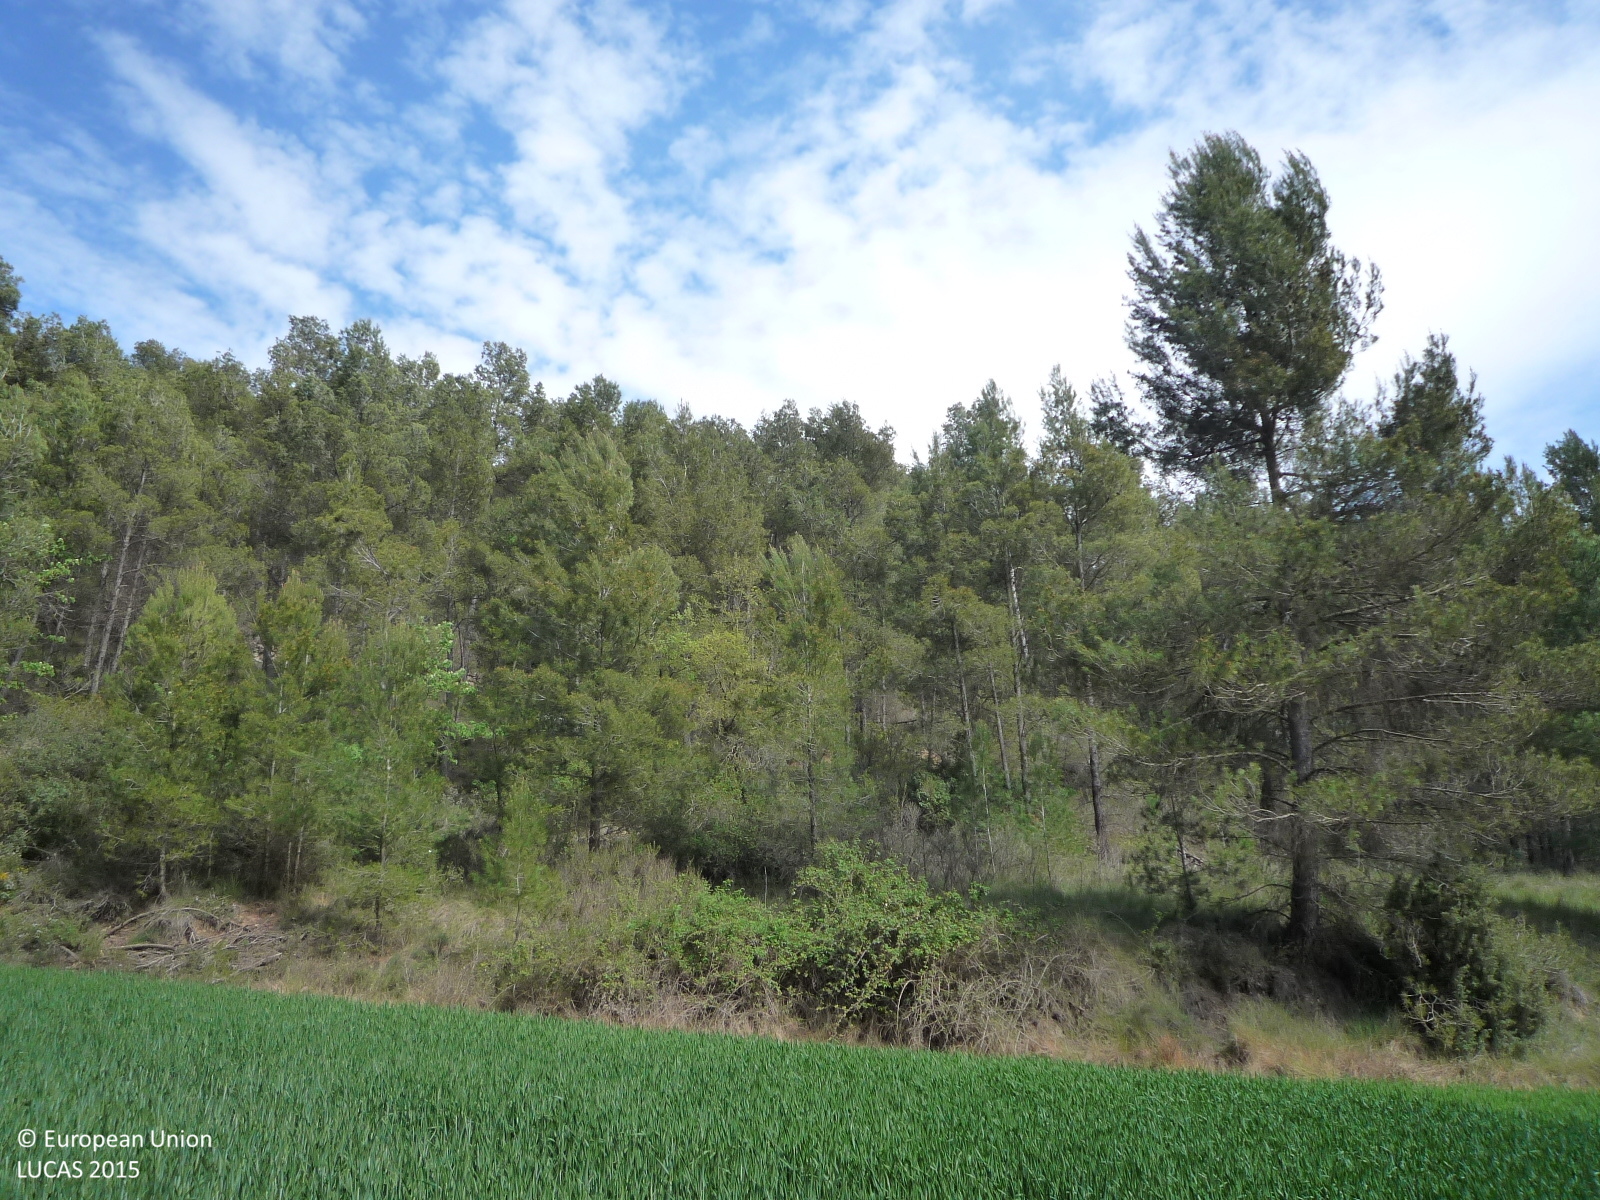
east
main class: Cropland
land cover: Durum wheat
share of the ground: > 75 %
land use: Agriculture (excluding fallow land and kitchen gardens)
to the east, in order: Durum wheat; Shruby margins; Pine dominated coniferous woodland; Dry stone walls; Pine dominated coniferous woodland; Rock outcrops; Pine dominated coniferous woodland; Tracks; Pine dominated coniferous woodland; Dry stone walls; Pine dominated coniferous woodland; Common wheat; Pine dominated coniferous woodland; Common wheat; Pine dominated coniferous woodland
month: April
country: ES
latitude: 41.7426
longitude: 1.6094
